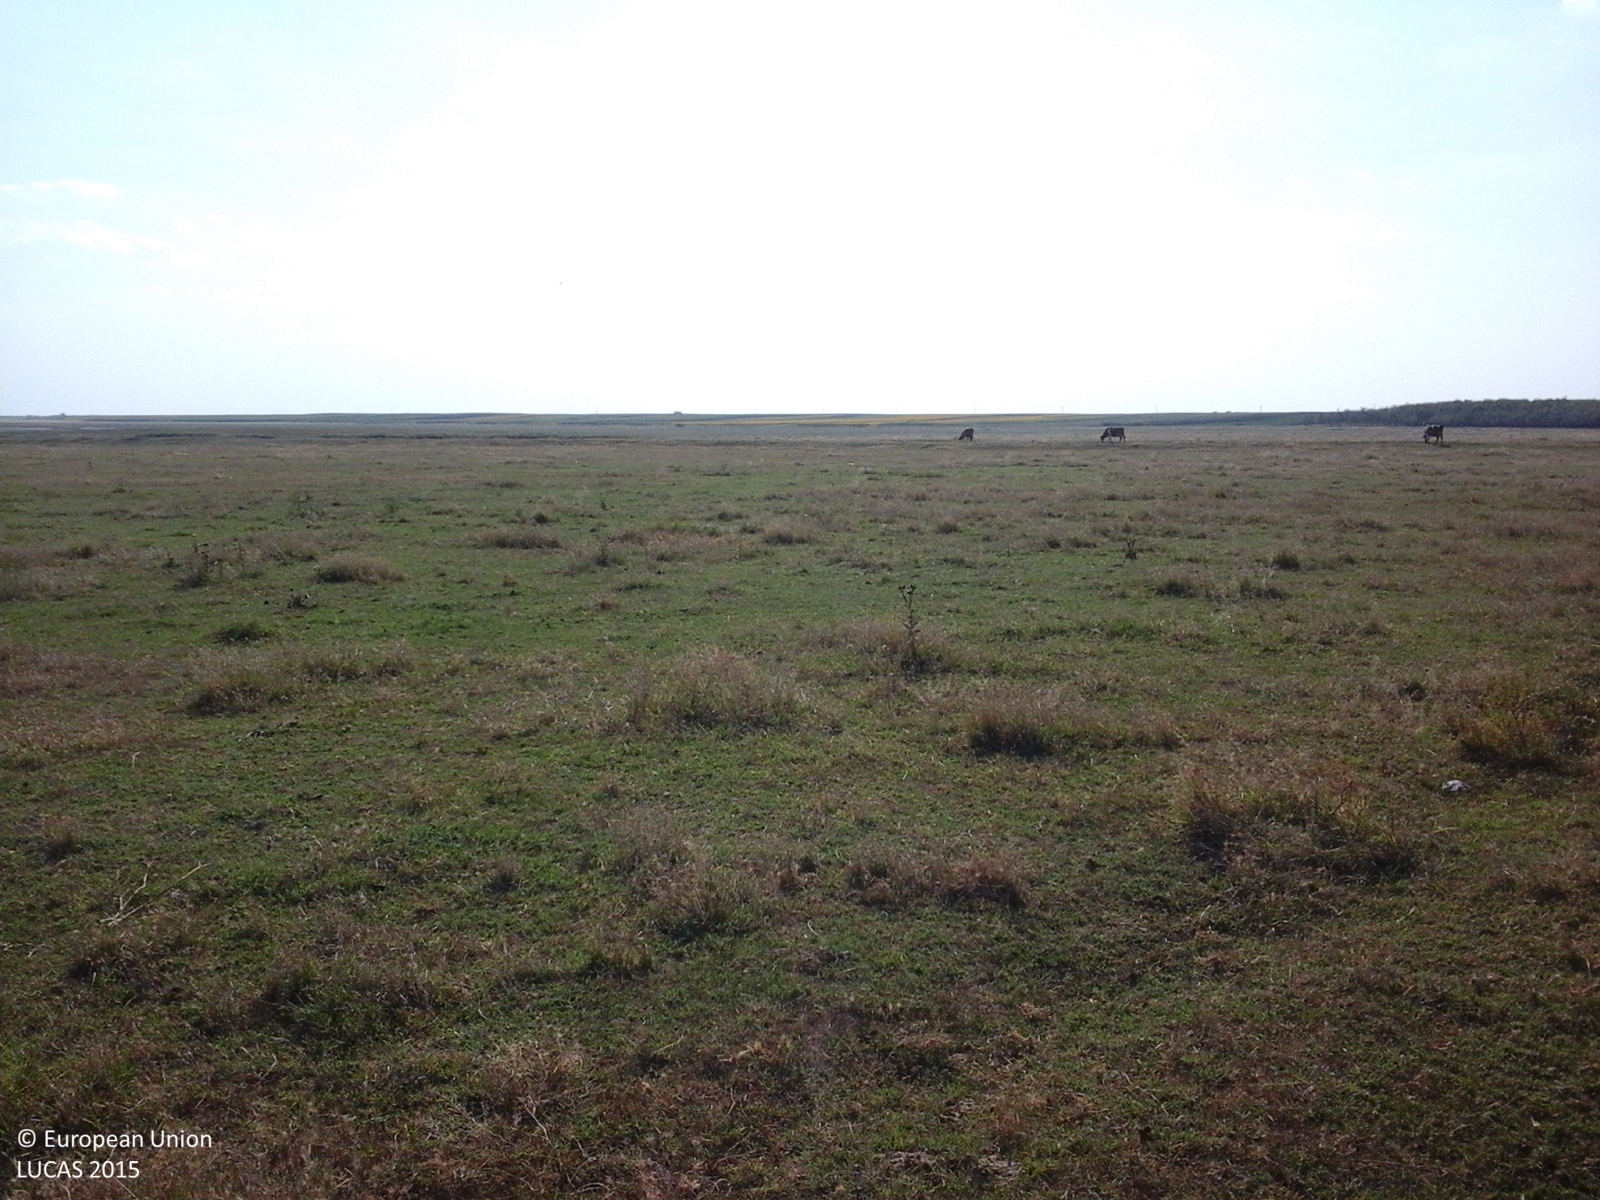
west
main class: Grassland
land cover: Grassland without tree/shrub cover
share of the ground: > 75 %
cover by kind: herbaceous plants 100 %
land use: Agriculture (excluding fallow land and kitchen gardens)
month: July
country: RO
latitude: 44.8037
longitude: 27.2706
